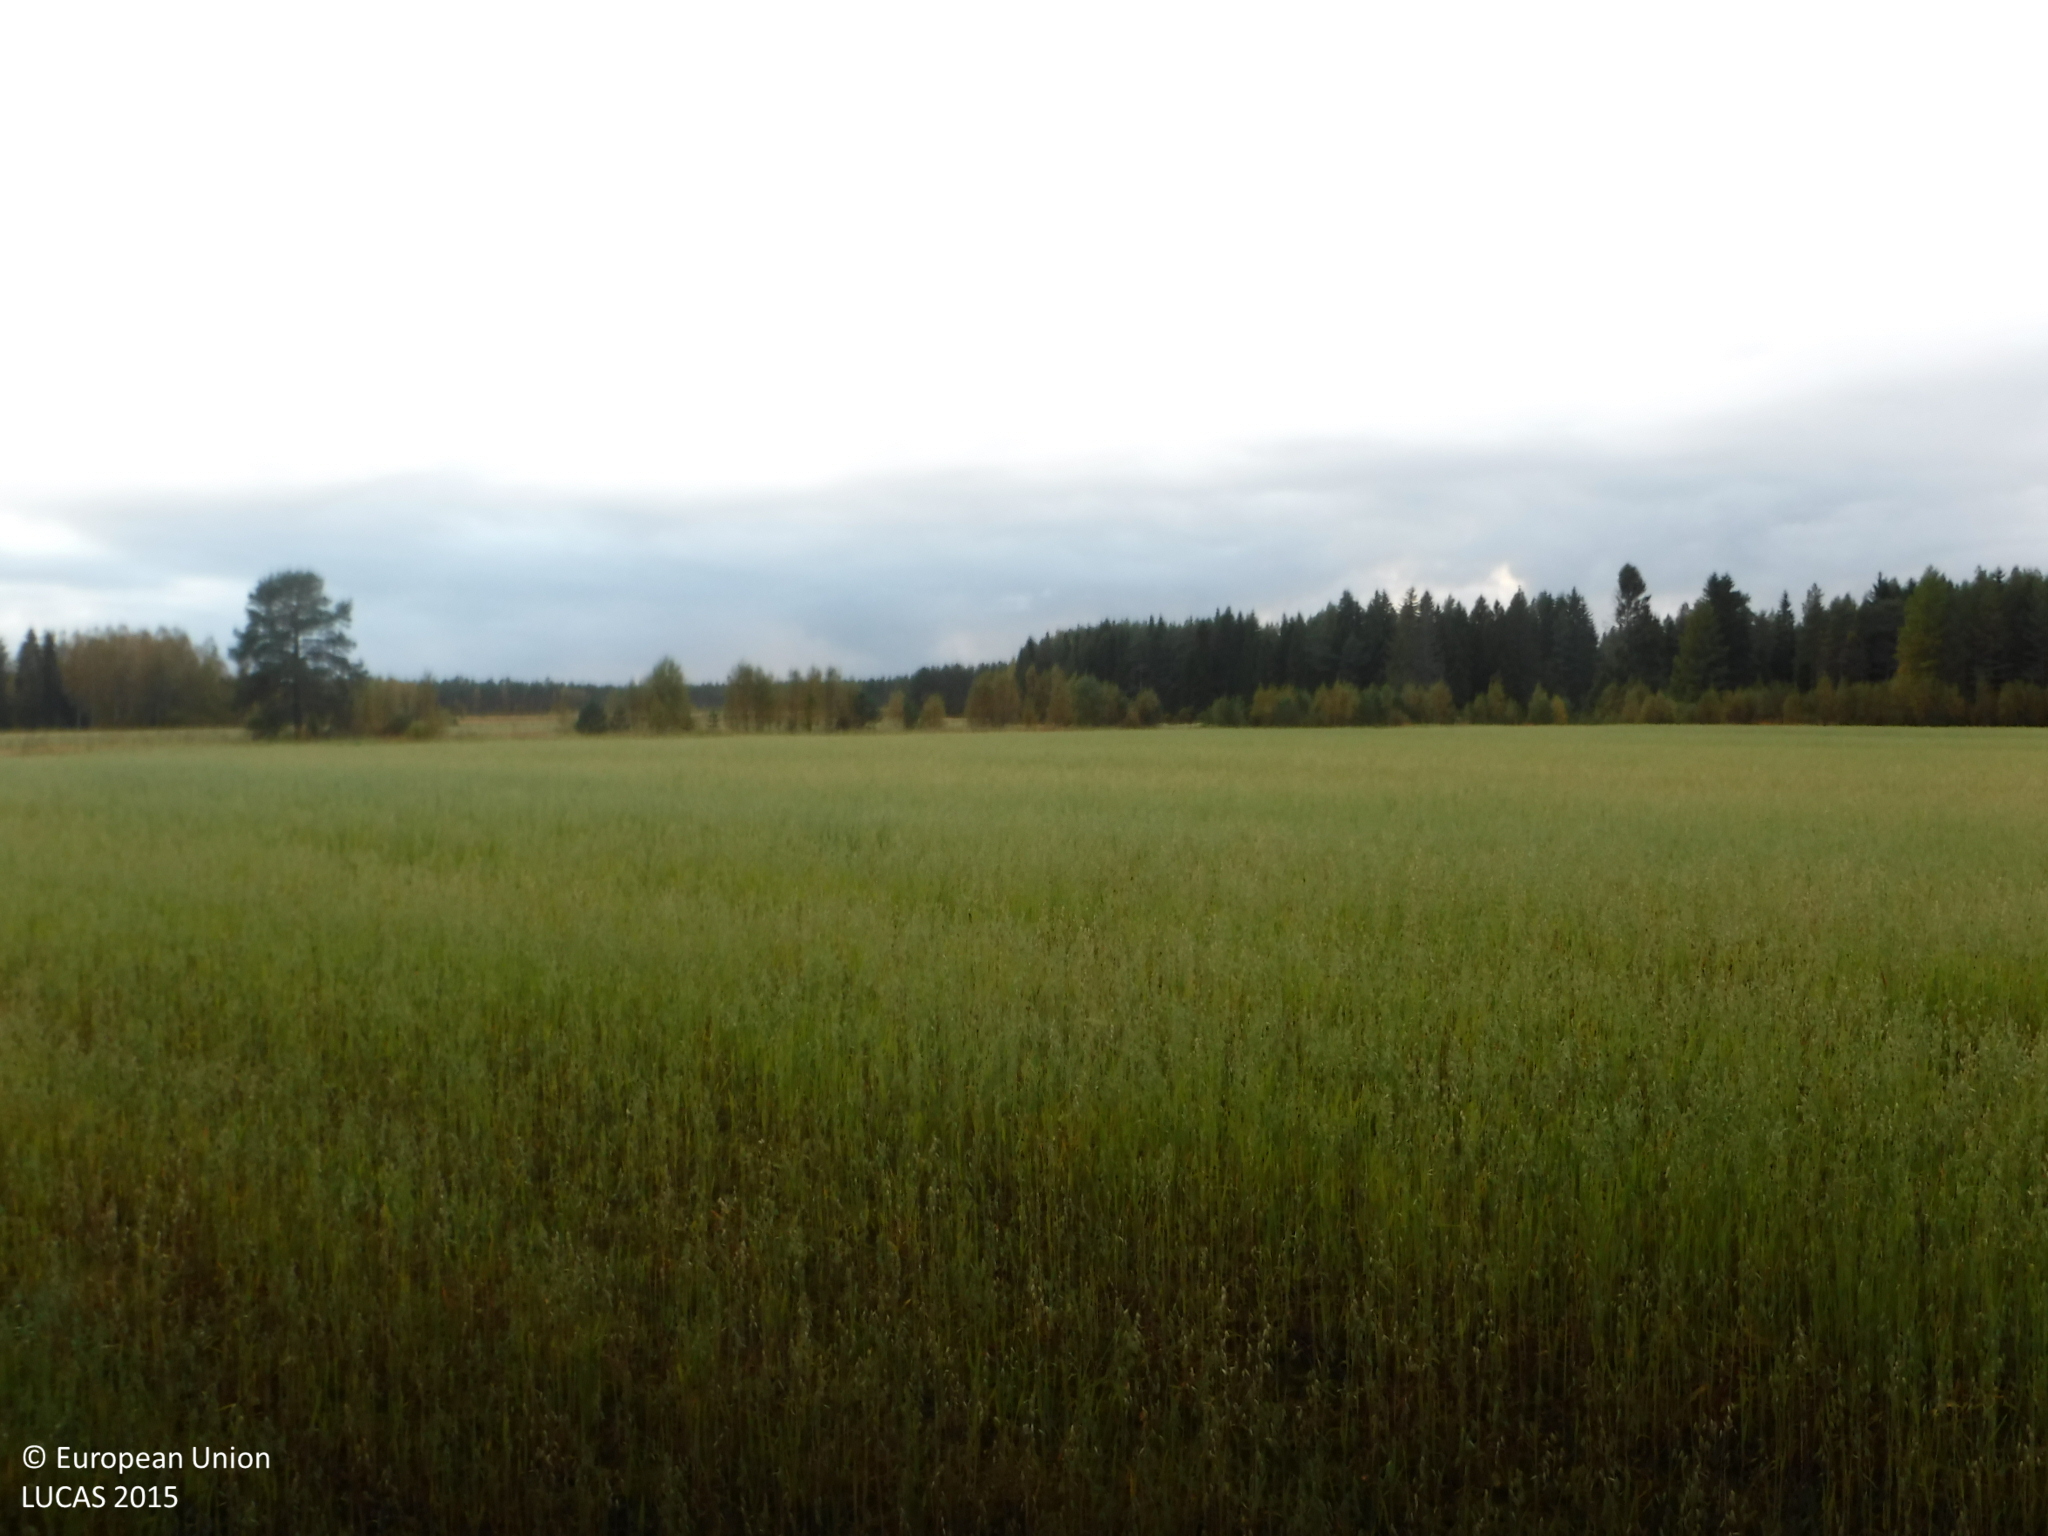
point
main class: Cropland
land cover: Oats
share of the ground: 50 - 75 %
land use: Agriculture (excluding fallow land and kitchen gardens)
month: September
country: FI
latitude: 62.0516
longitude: 22.5105
